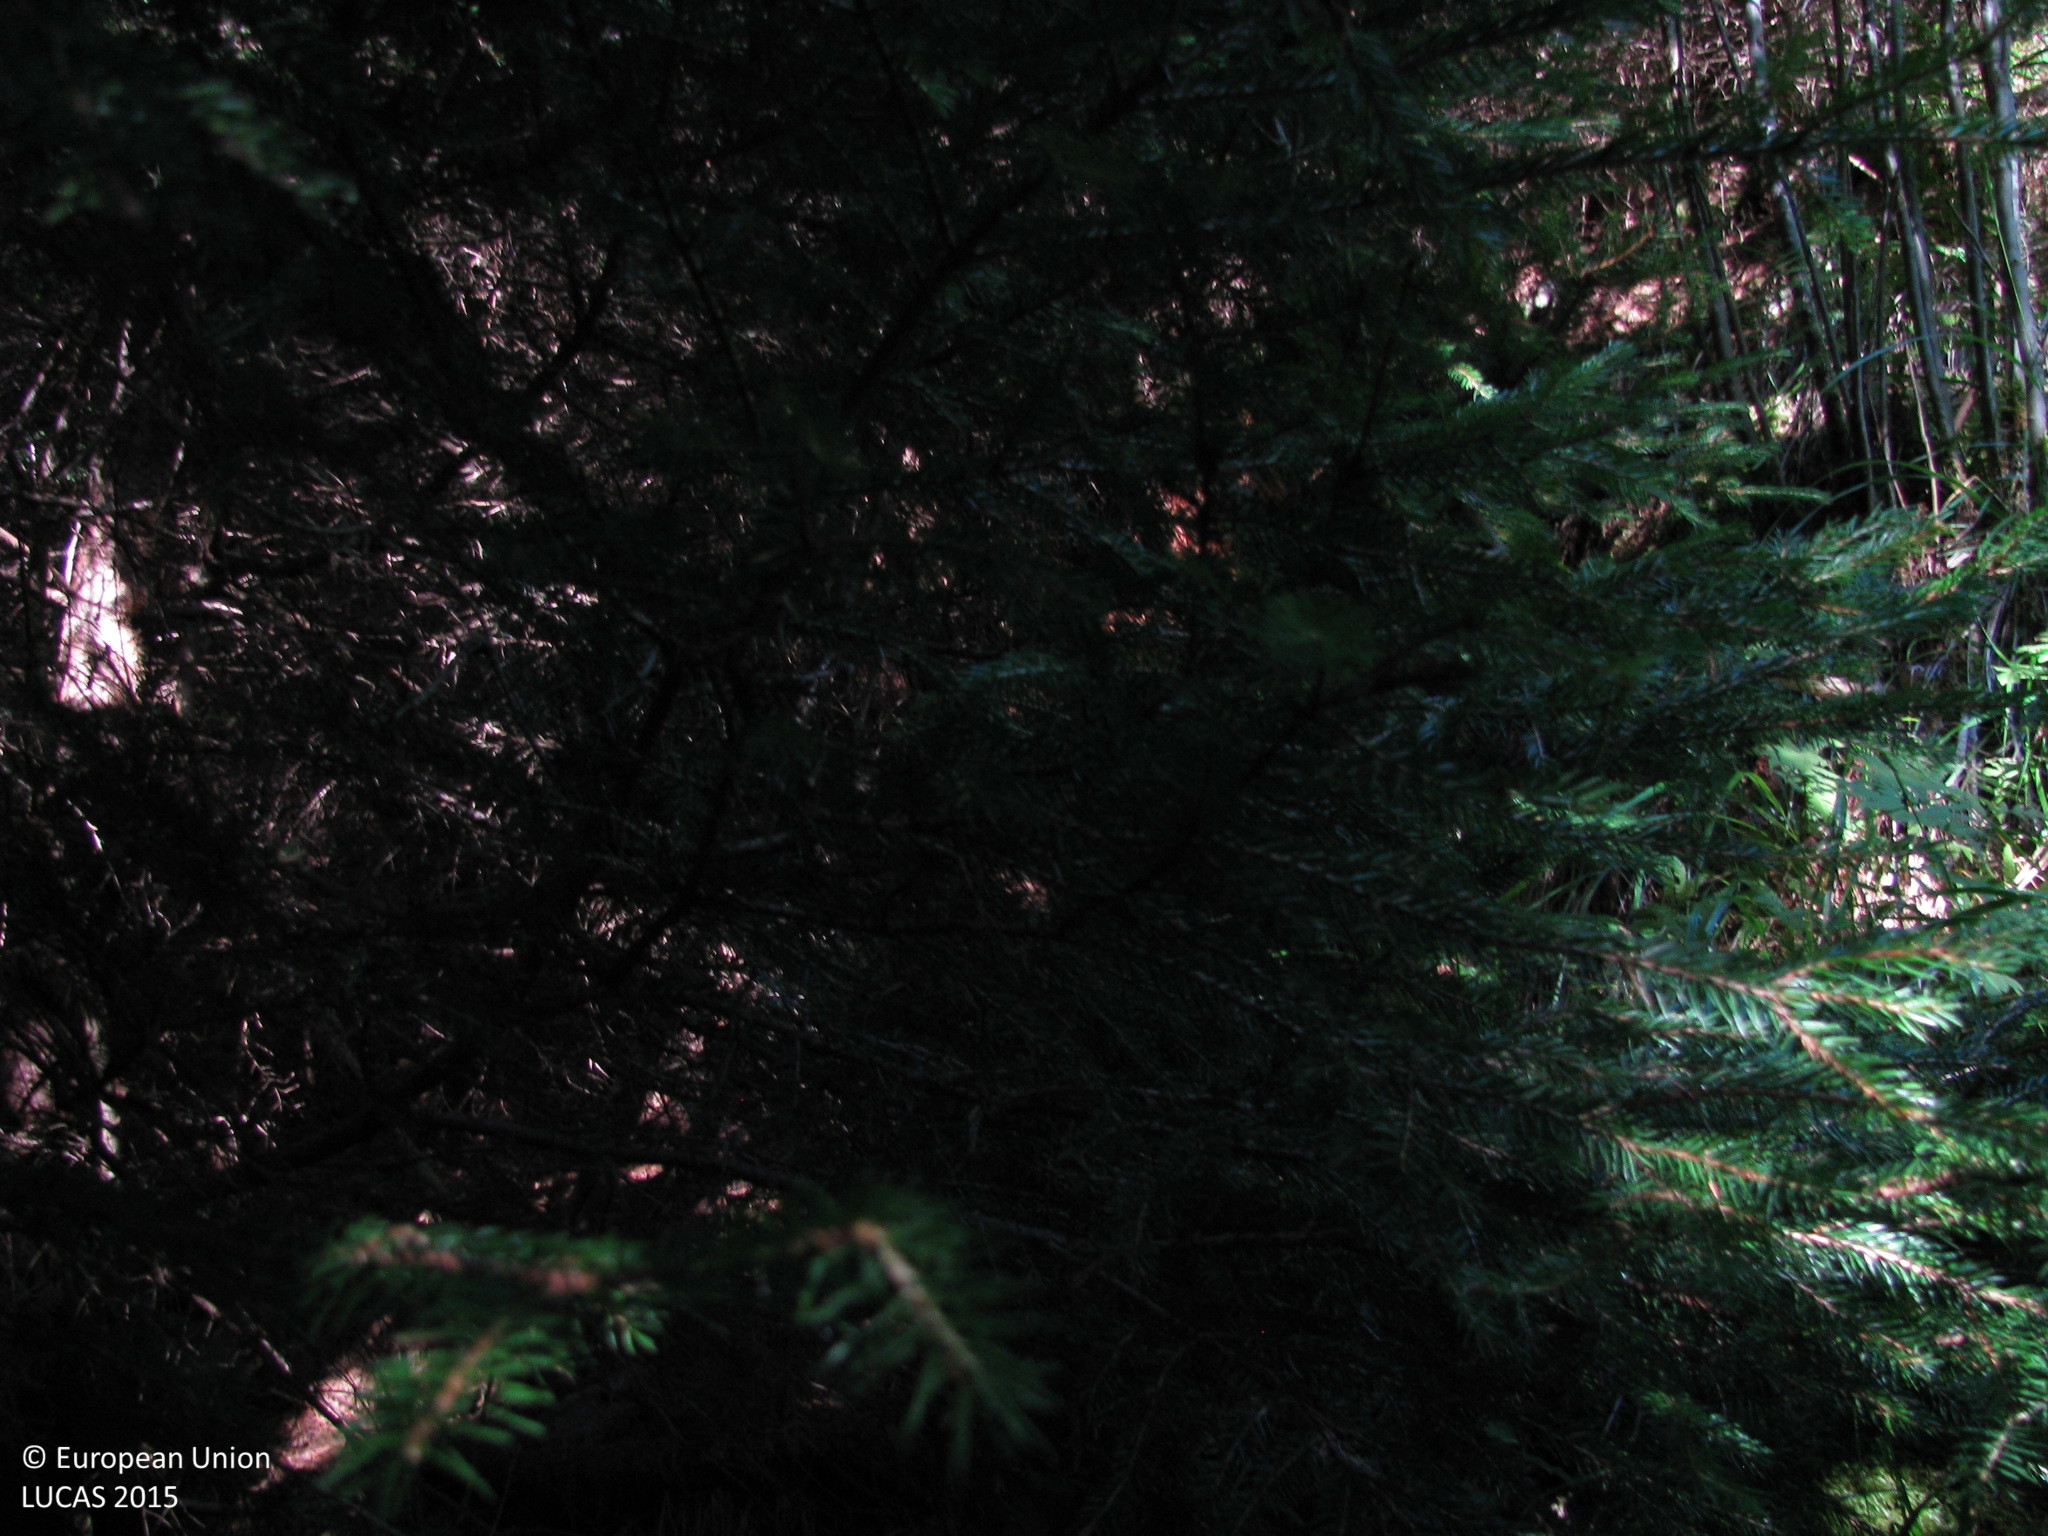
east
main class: Woodland
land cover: Spruce dominated coniferous woodland
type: alpine coniferous forest
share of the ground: > 75 %
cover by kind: coniferous forest trees 80 %, herbaceous plants 15 %, shrubs 5 %
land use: Forestry
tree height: > 5 m
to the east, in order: Spruce dominated coniferous woodland; Rivers and streams; Broadleaved woodland; Spontaneously vegetated surfaces; Spruce dominated coniferous woodland; Spontaneously vegetated surfaces; Spruce dominated coniferous woodland
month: July
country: AT
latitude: 47.2467
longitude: 14.9538
